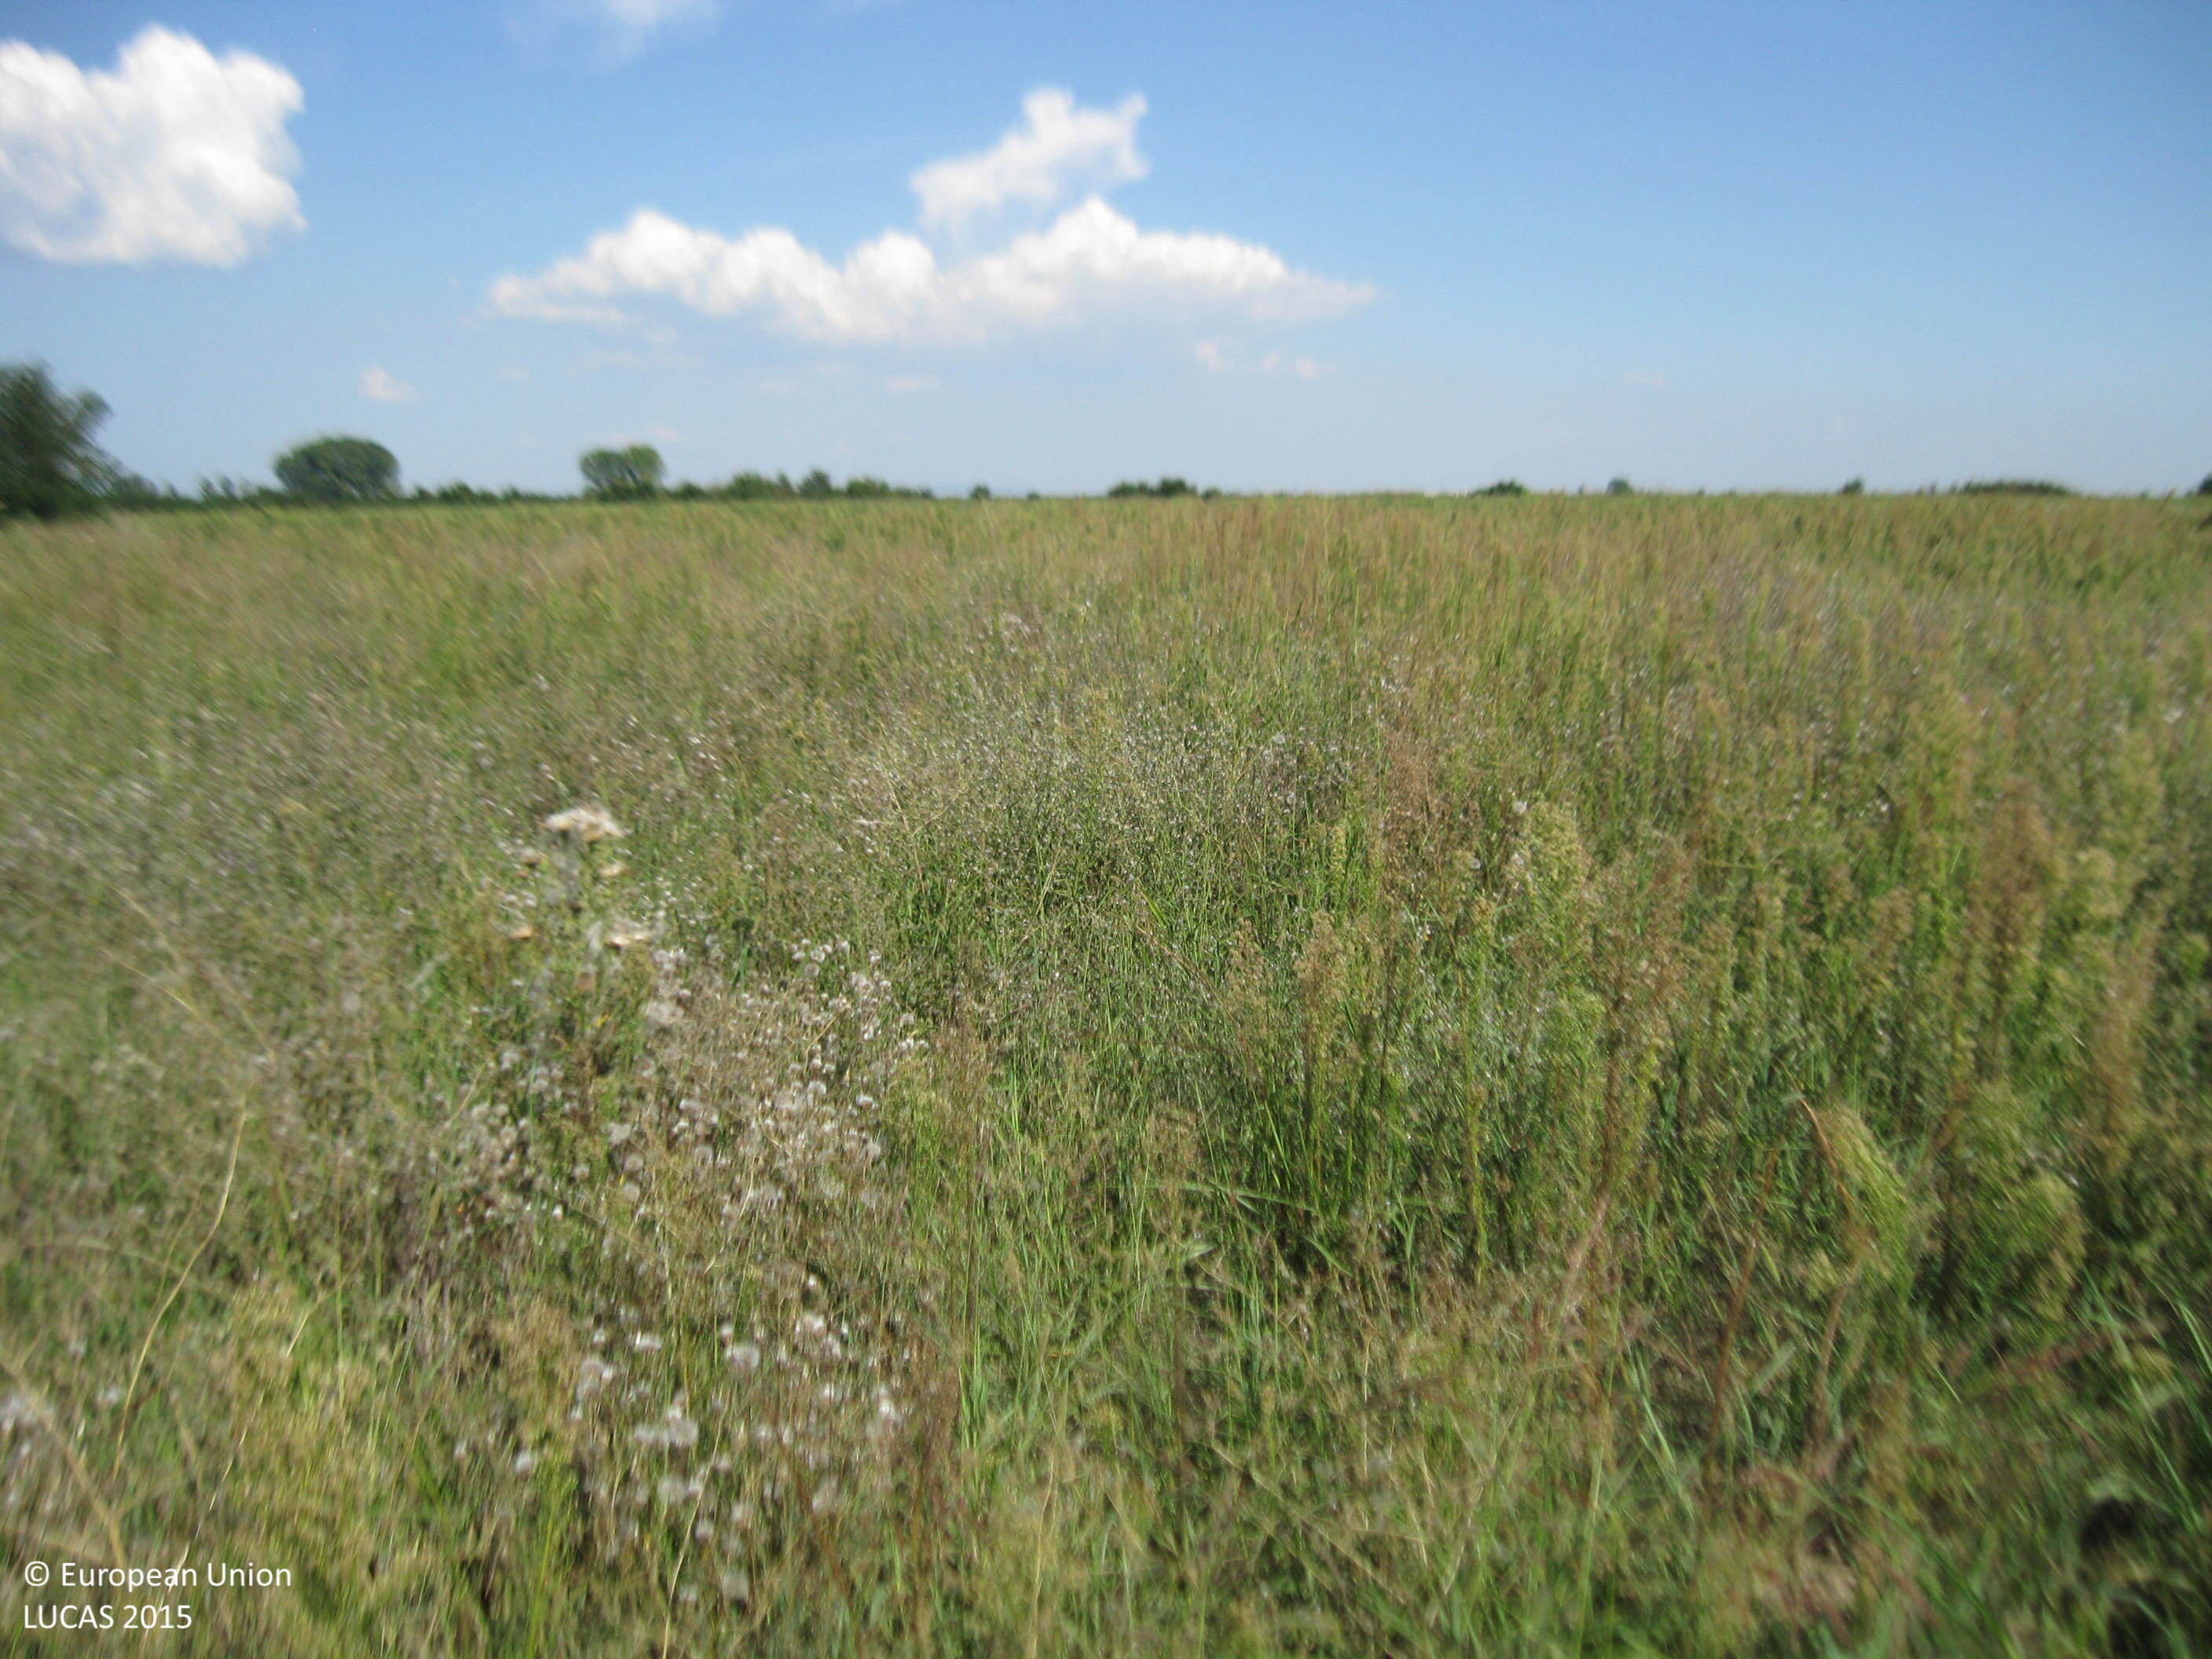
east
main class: Grassland
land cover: Spontaneously vegetated surfaces
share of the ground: > 75 %
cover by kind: herbaceous plants 100 %
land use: Fallow land
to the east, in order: Spontaneously vegetated surfaces; Tracks; Grass margins; Permanent industrial crops; Tracks; Permanent industrial crops
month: September
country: BG
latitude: 42.2944
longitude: 24.7905
